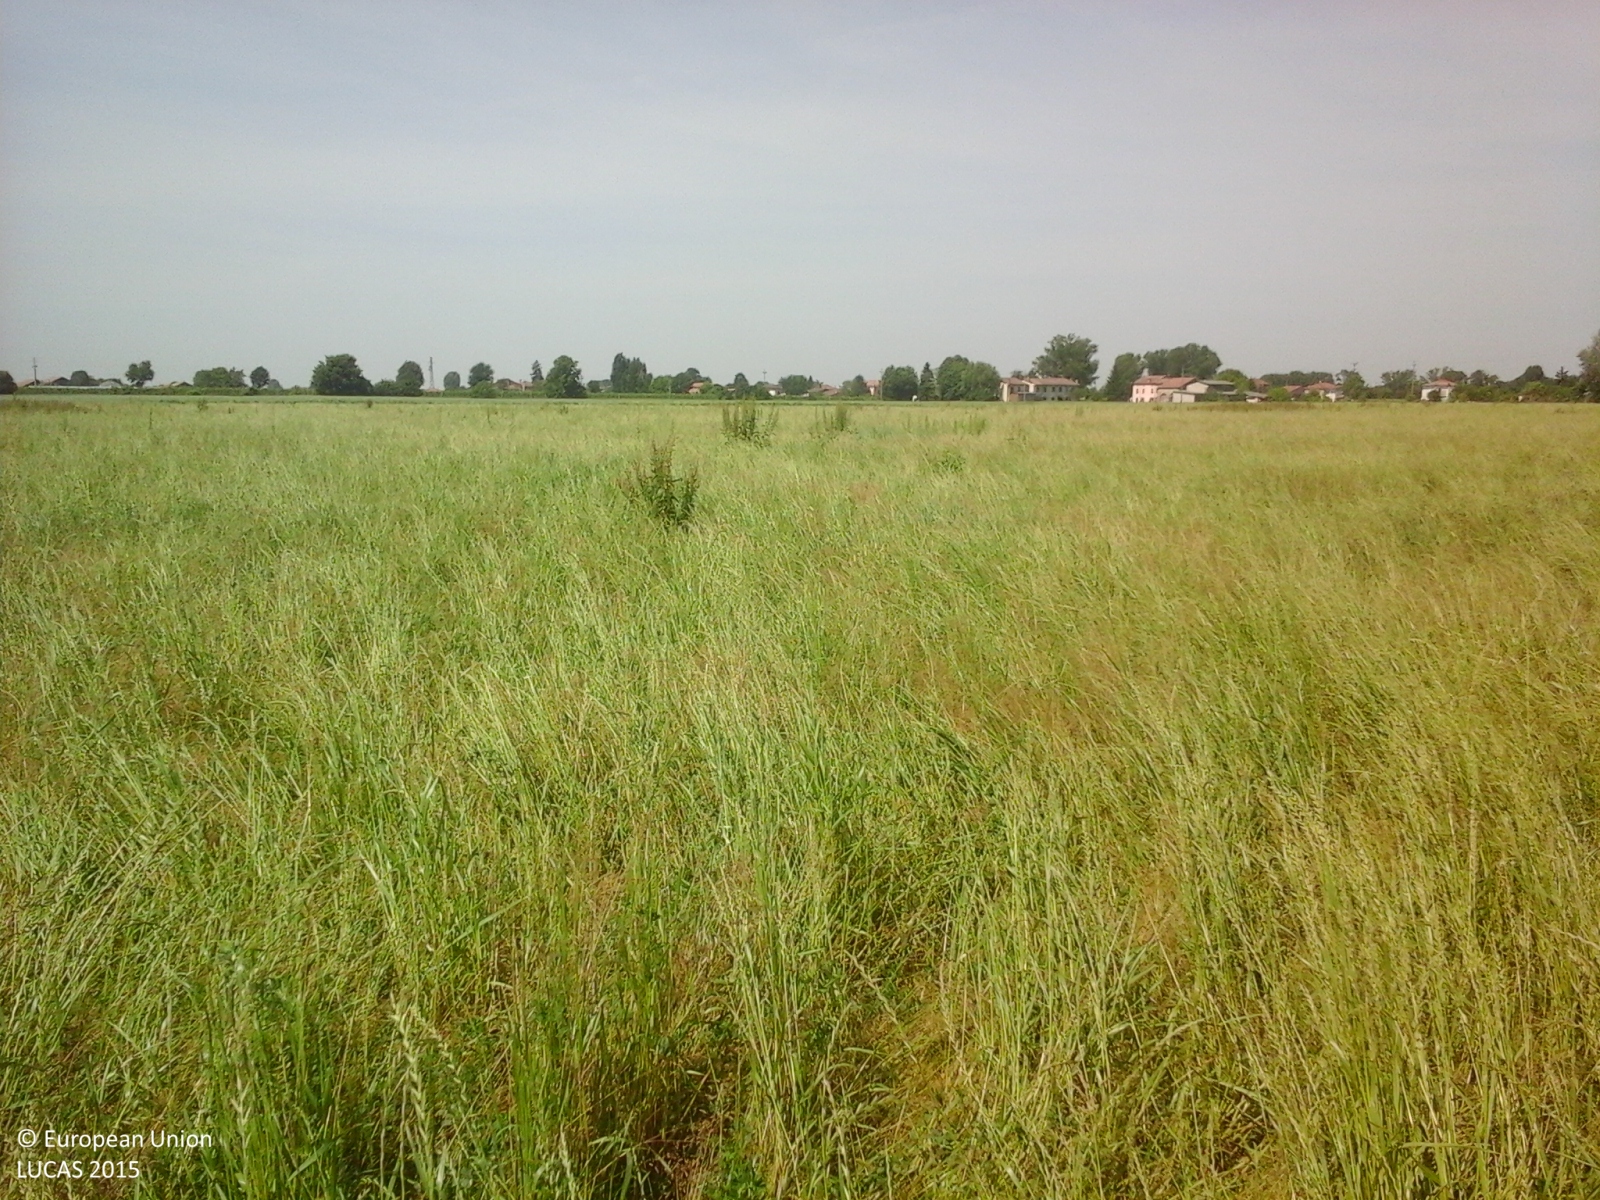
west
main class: Cropland
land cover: Lucerne
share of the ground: > 75 %
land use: Agriculture (excluding fallow land and kitchen gardens)
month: May
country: IT
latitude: 44.9947
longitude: 11.0255
